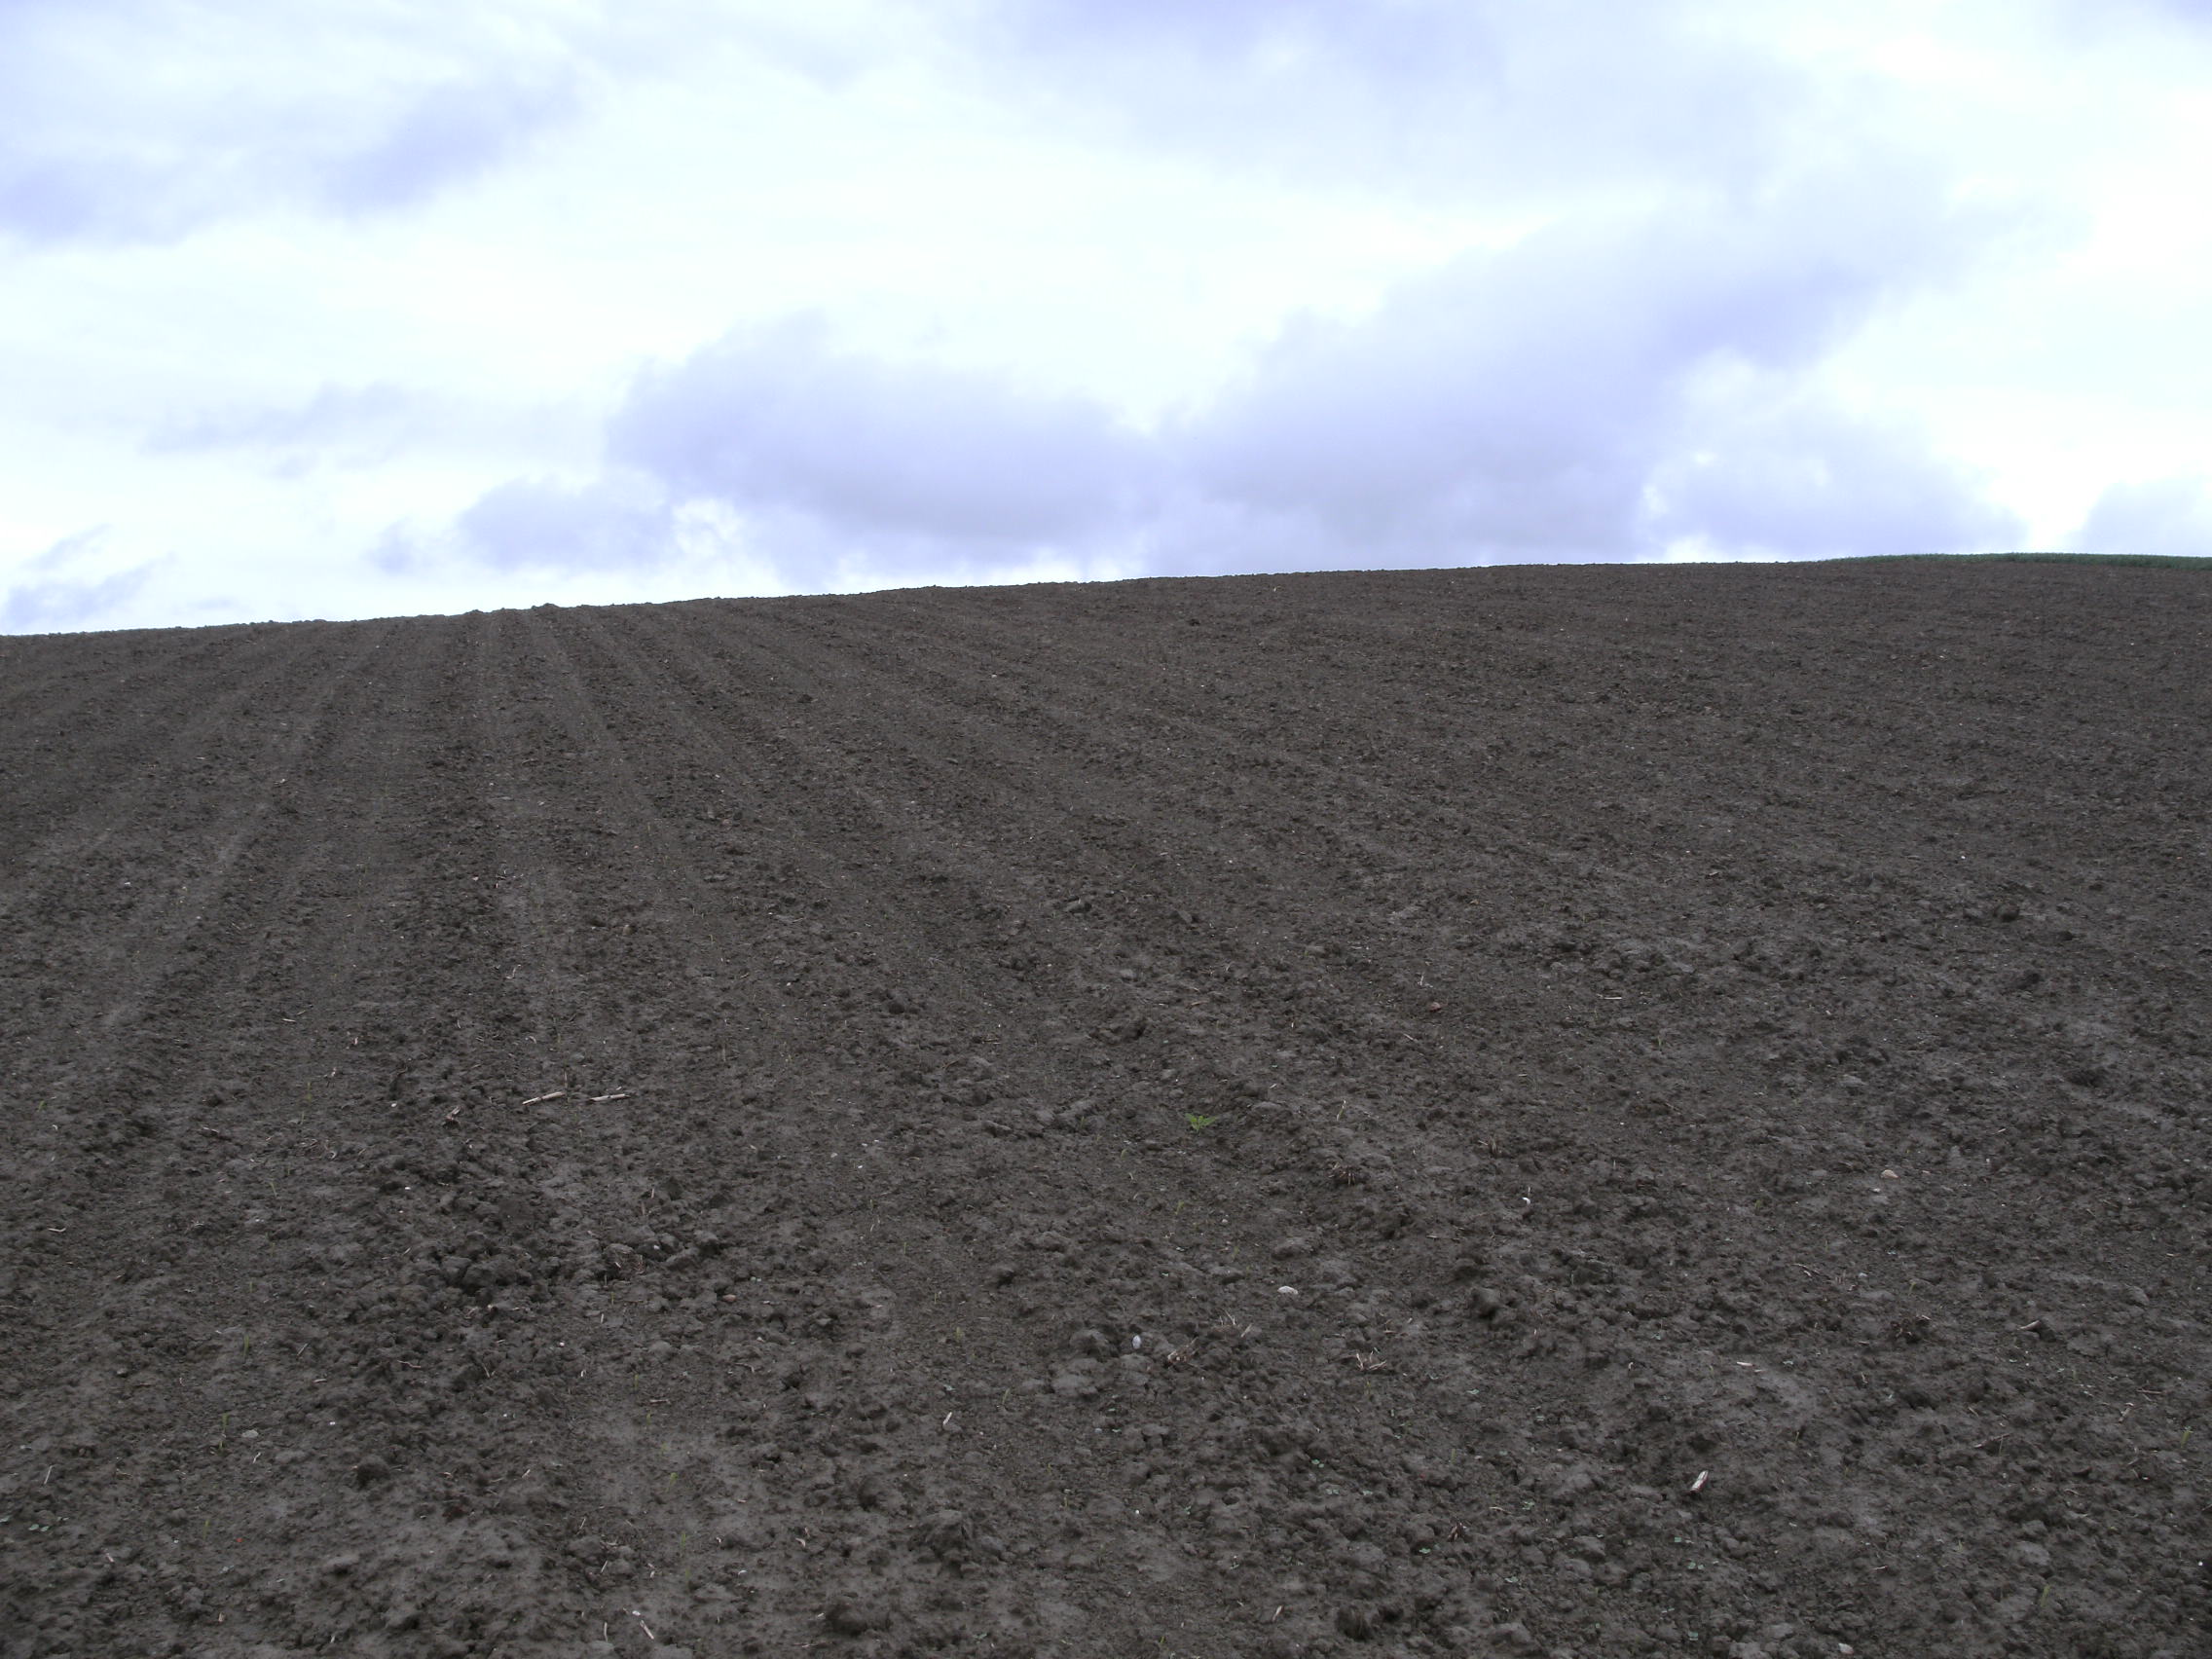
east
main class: Cropland
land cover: Maize
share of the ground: < 10 %
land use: Agriculture (excluding fallow land and kitchen gardens)
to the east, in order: Maize
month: May
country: AT
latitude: 48.2601
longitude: 13.4342
